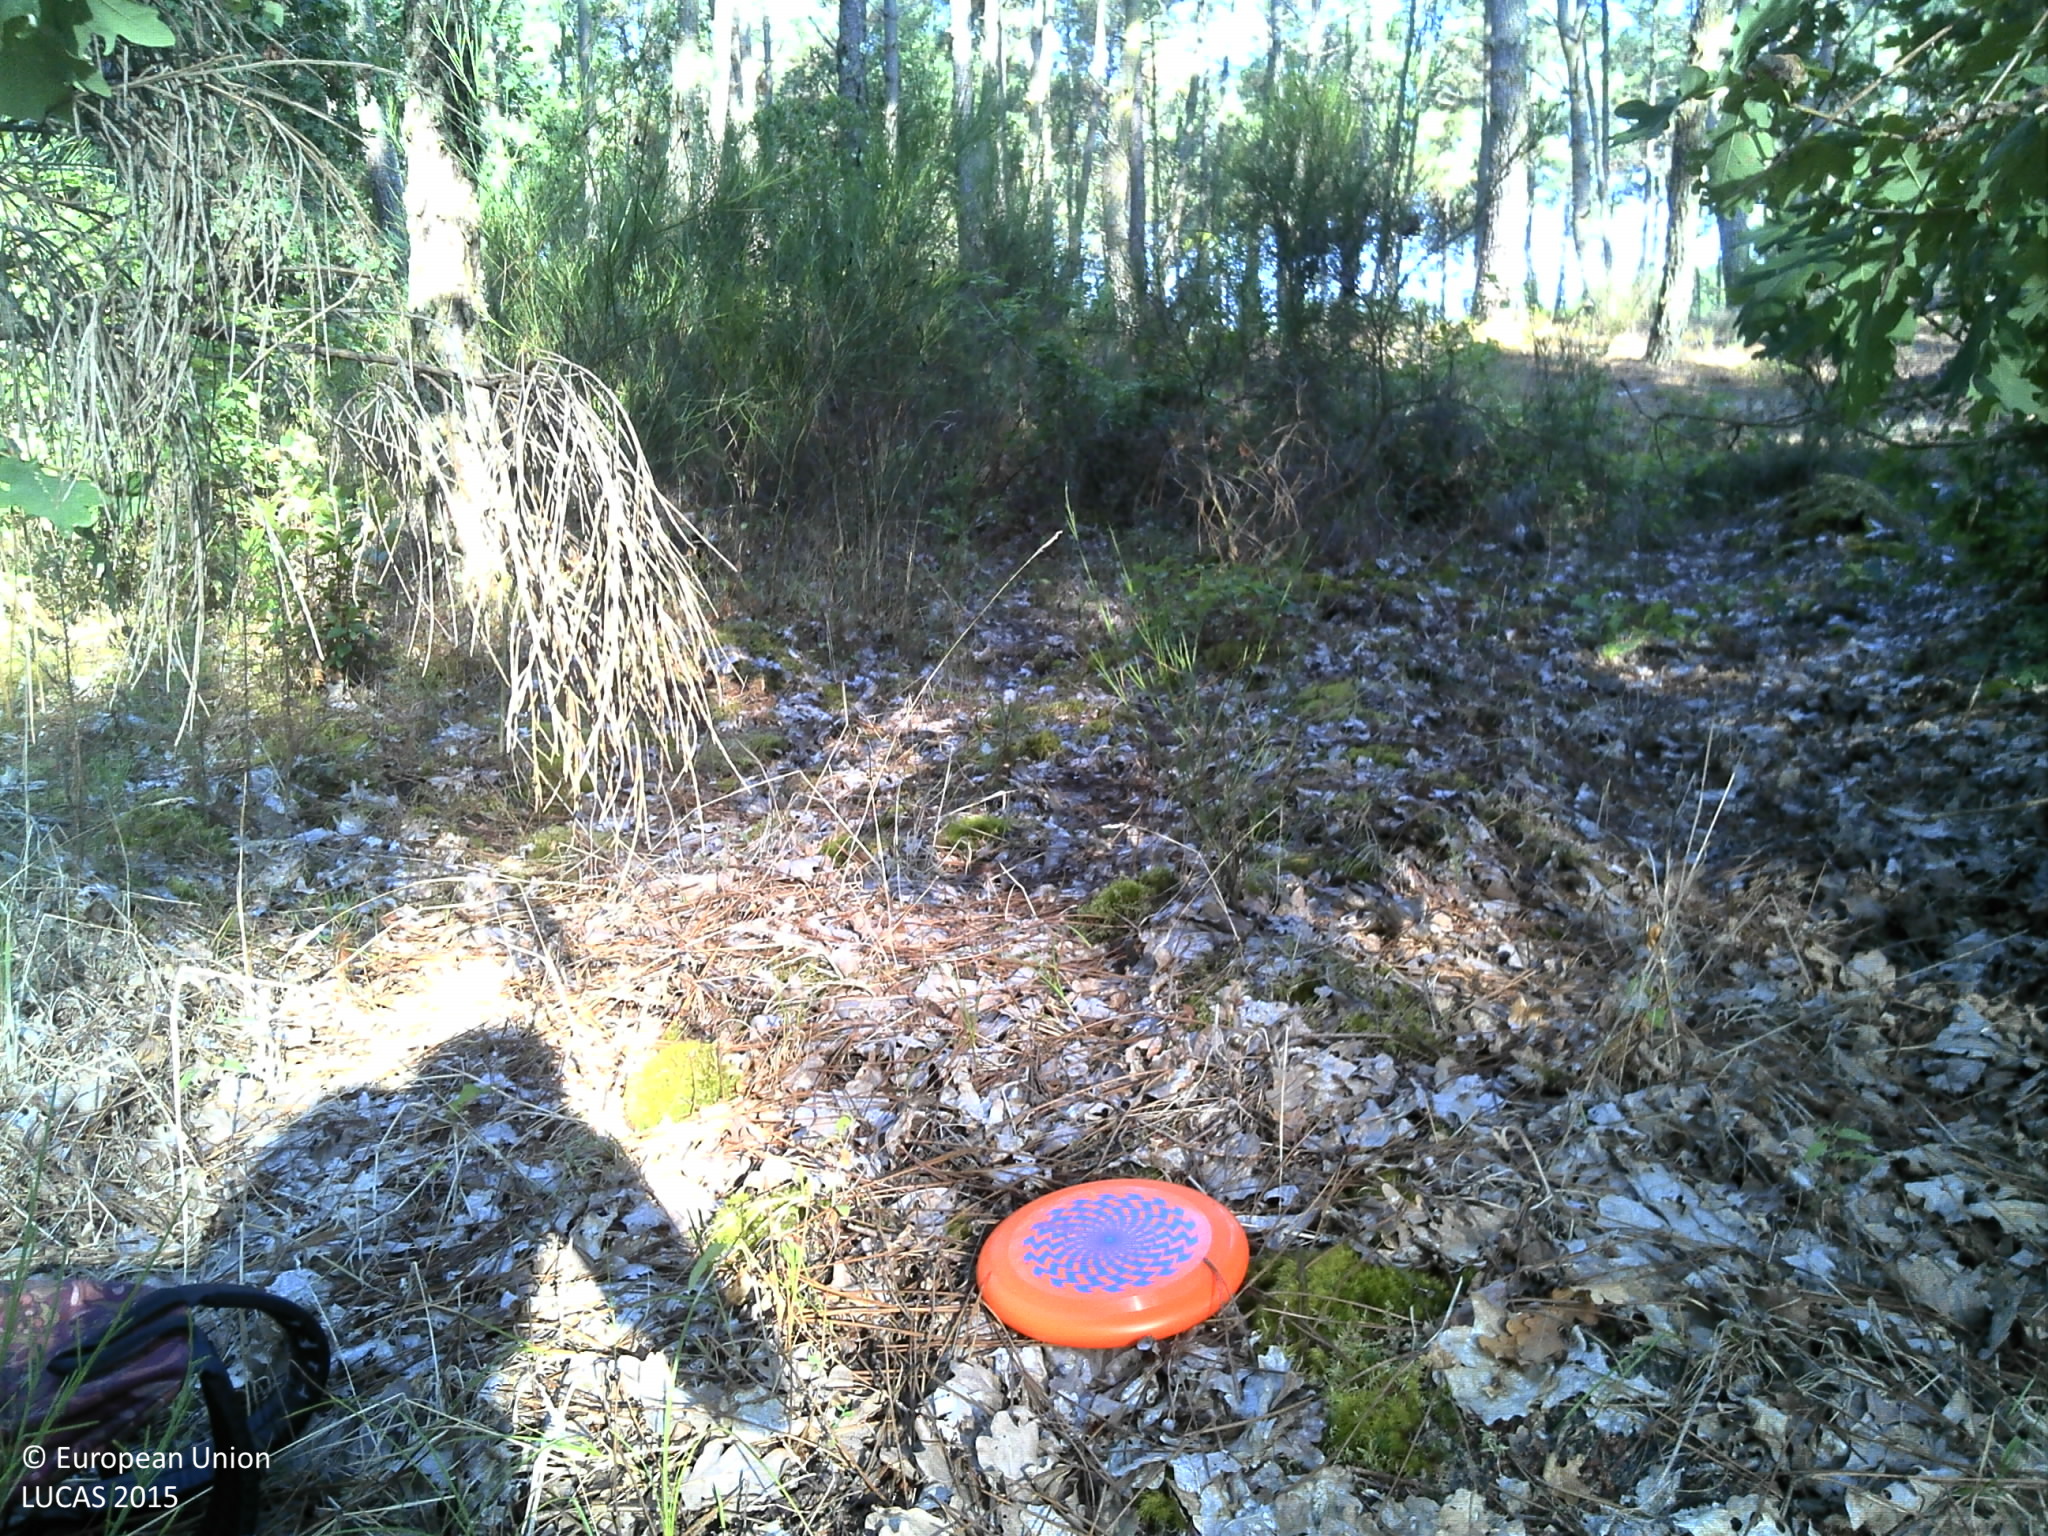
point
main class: Woodland
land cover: Broadleaved woodland
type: coniferous forest of the mediterranean region
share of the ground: > 75 %
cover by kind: broadleaved forest trees 50 %, shrubs 30 %, coniferous forest trees 10 %, herbaceous plants 5 %, lichens and mosses 5 %
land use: Forestry
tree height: > 5 m
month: August
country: FR
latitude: 44.7988
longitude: -1.1870
